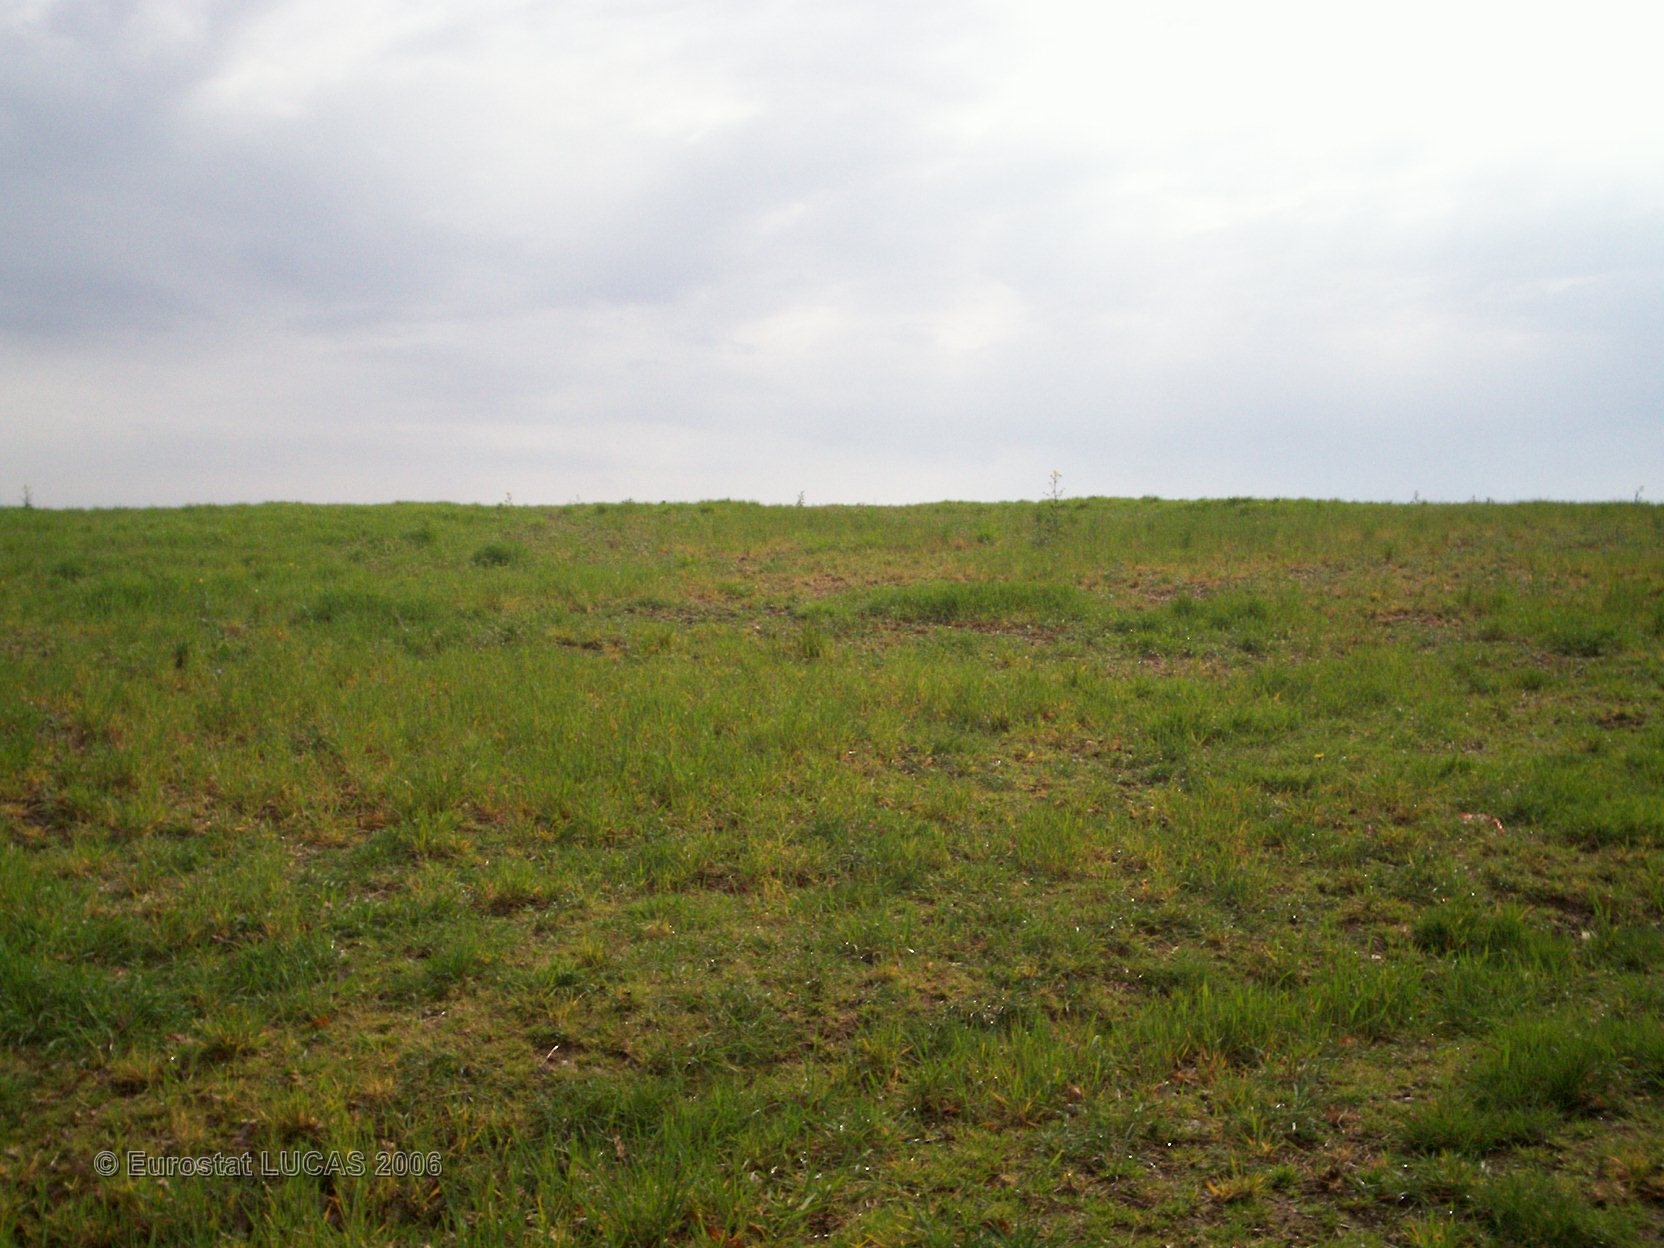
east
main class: Grassland
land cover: Grassland without tree/shrub cover
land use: Agriculture (excluding fallow land and kitchen gardens)
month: April
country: FR
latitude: 48.0475
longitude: -2.8771
